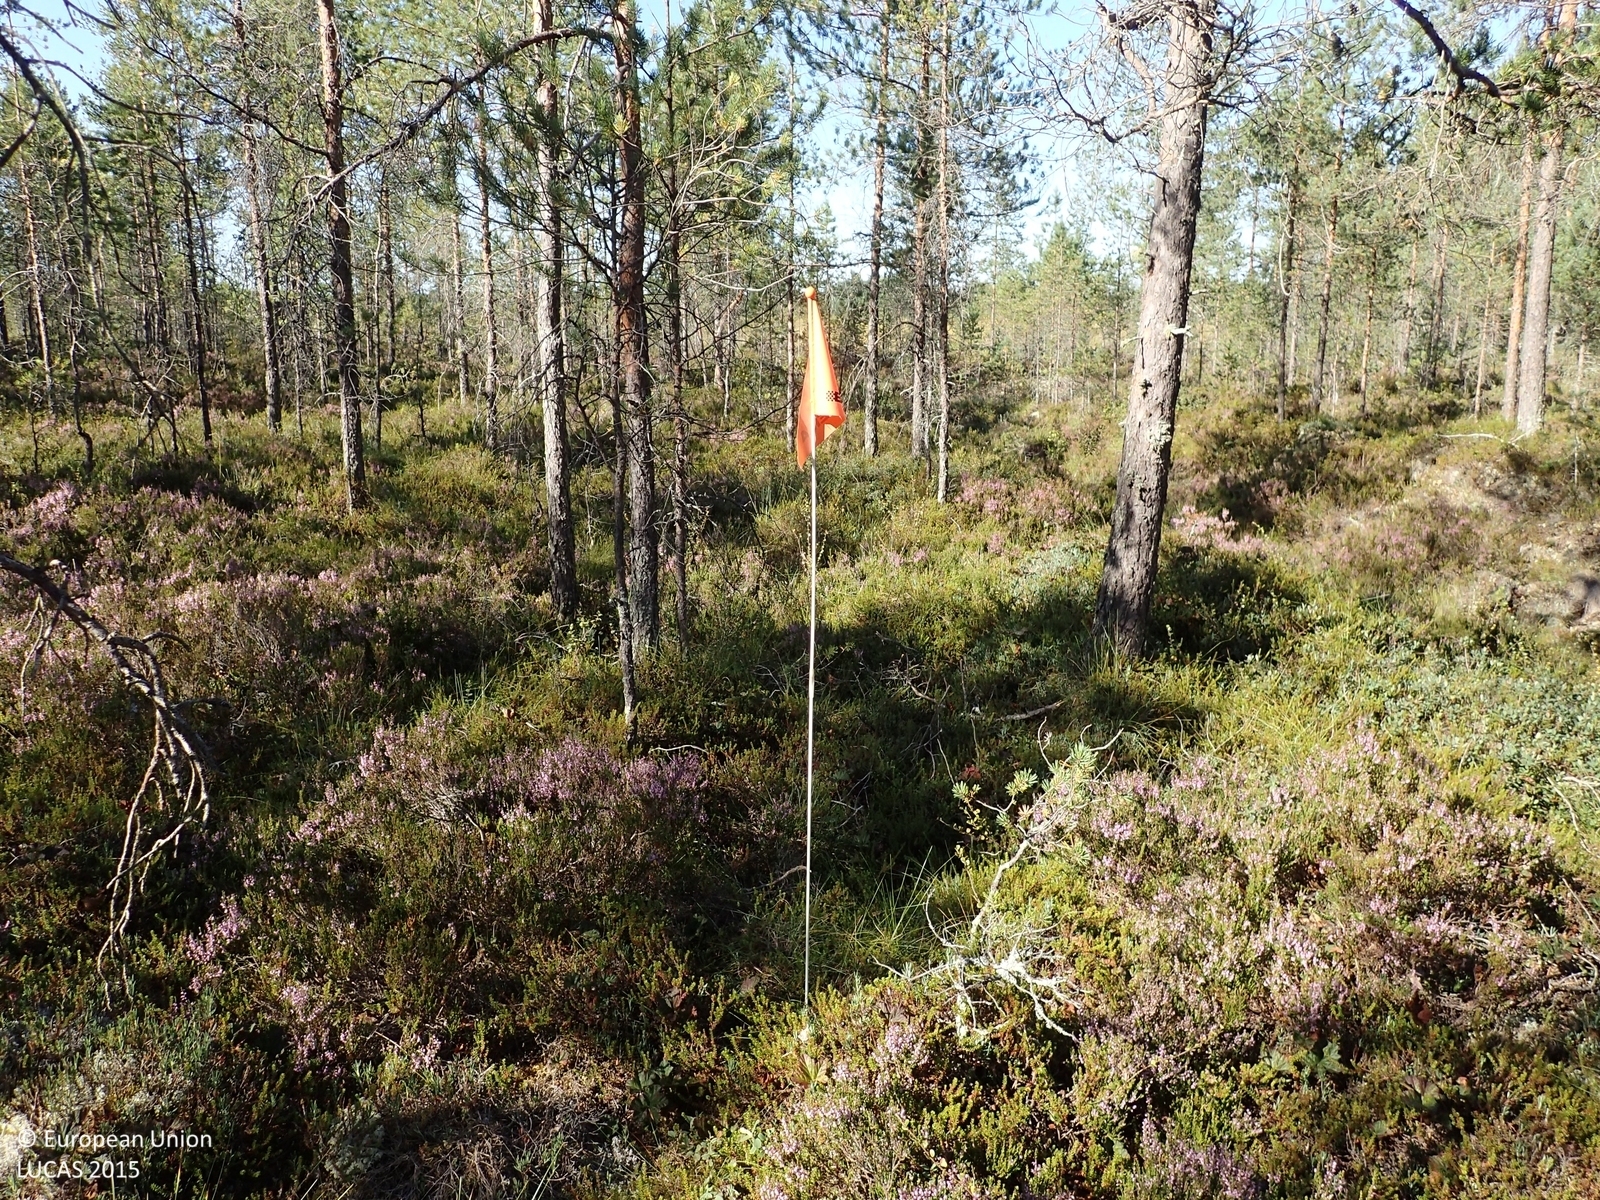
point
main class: Woodland
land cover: Pine dominated coniferous woodland
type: boreal forest
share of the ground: 25 - 50 %
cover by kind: shrubs 55 %, coniferous forest trees 45 %
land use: Forestry
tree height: < 5 m
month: August
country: FI
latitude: 62.6206
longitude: 22.7075
